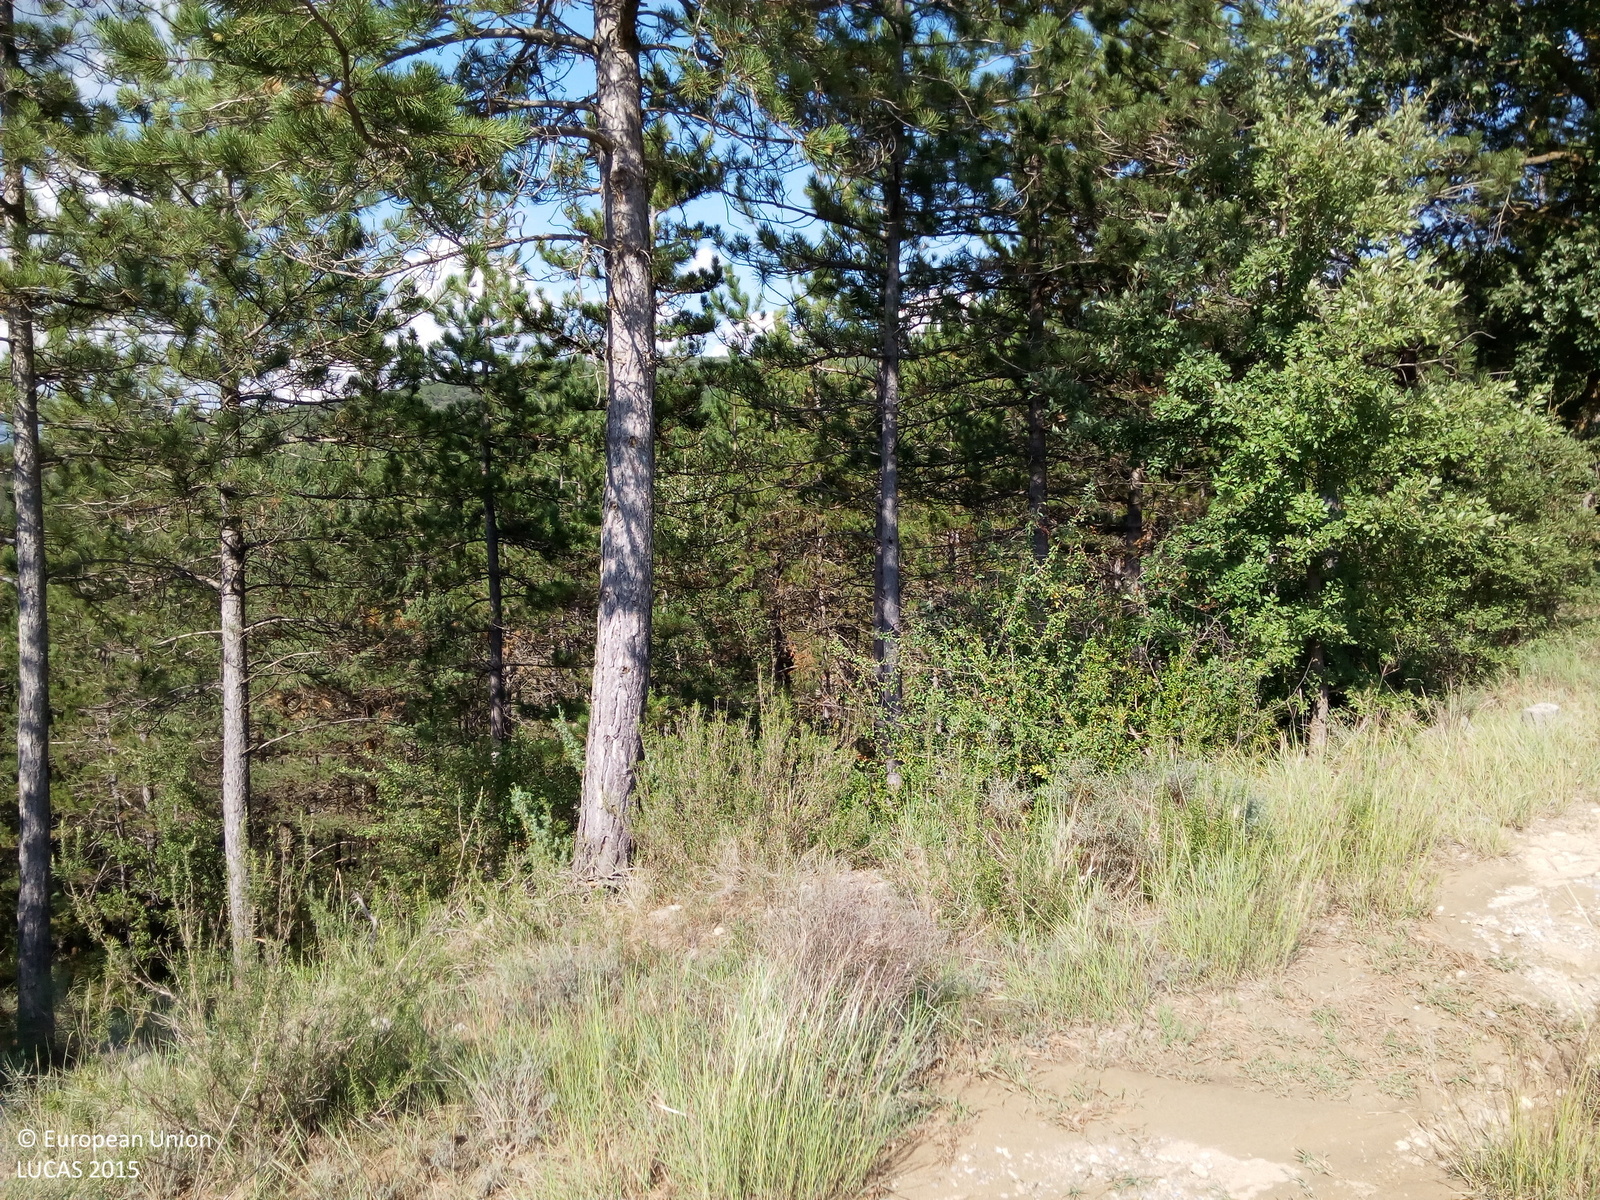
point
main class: Woodland
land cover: Pine dominated mixed woodland
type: coniferous forest of the mediterranean region
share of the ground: > 75 %
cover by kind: coniferous forest trees 50 %, shrubs 30 %, broadleaved forest trees 20 %
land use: Forestry
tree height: > 5 m
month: August
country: ES
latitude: 42.2266
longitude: 0.5200
